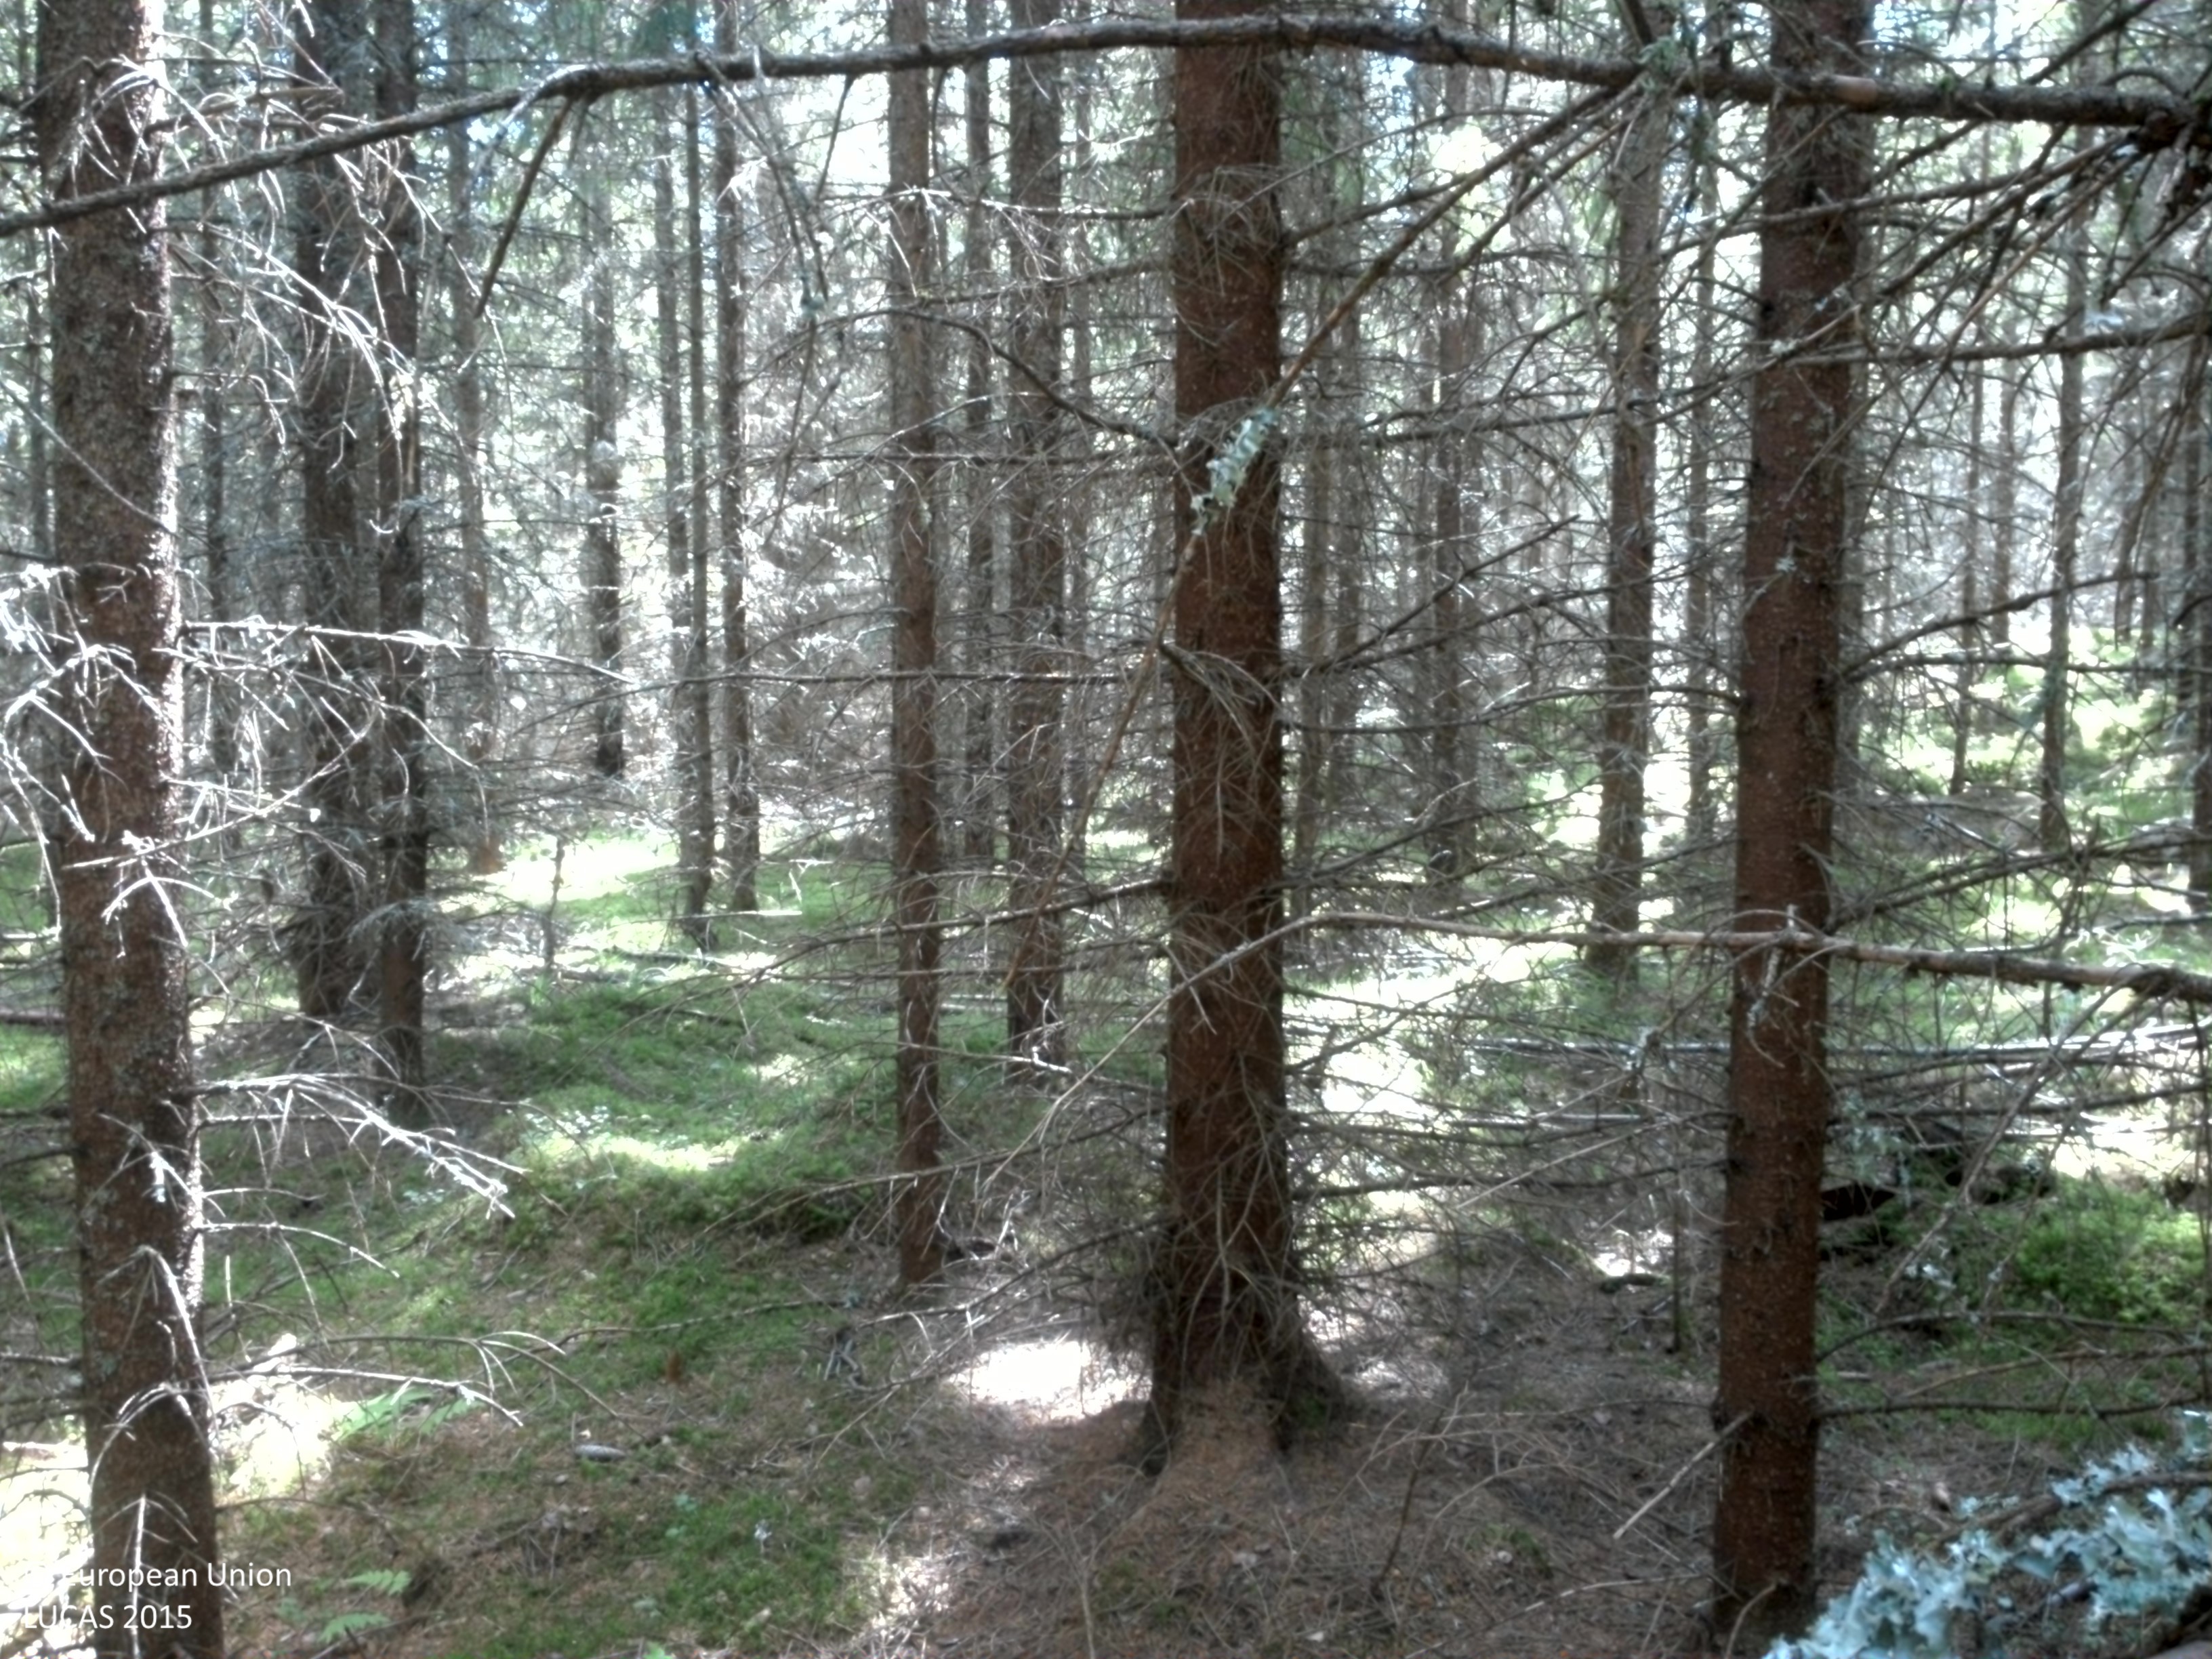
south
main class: Woodland
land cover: Spruce dominated coniferous woodland
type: boreal forest
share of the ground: > 75 %
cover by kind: coniferous forest trees 85 %, lichens and mosses 15 %
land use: Forestry
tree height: > 5 m
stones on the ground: > 50 %
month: July
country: SE
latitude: 59.6159
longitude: 14.6877
